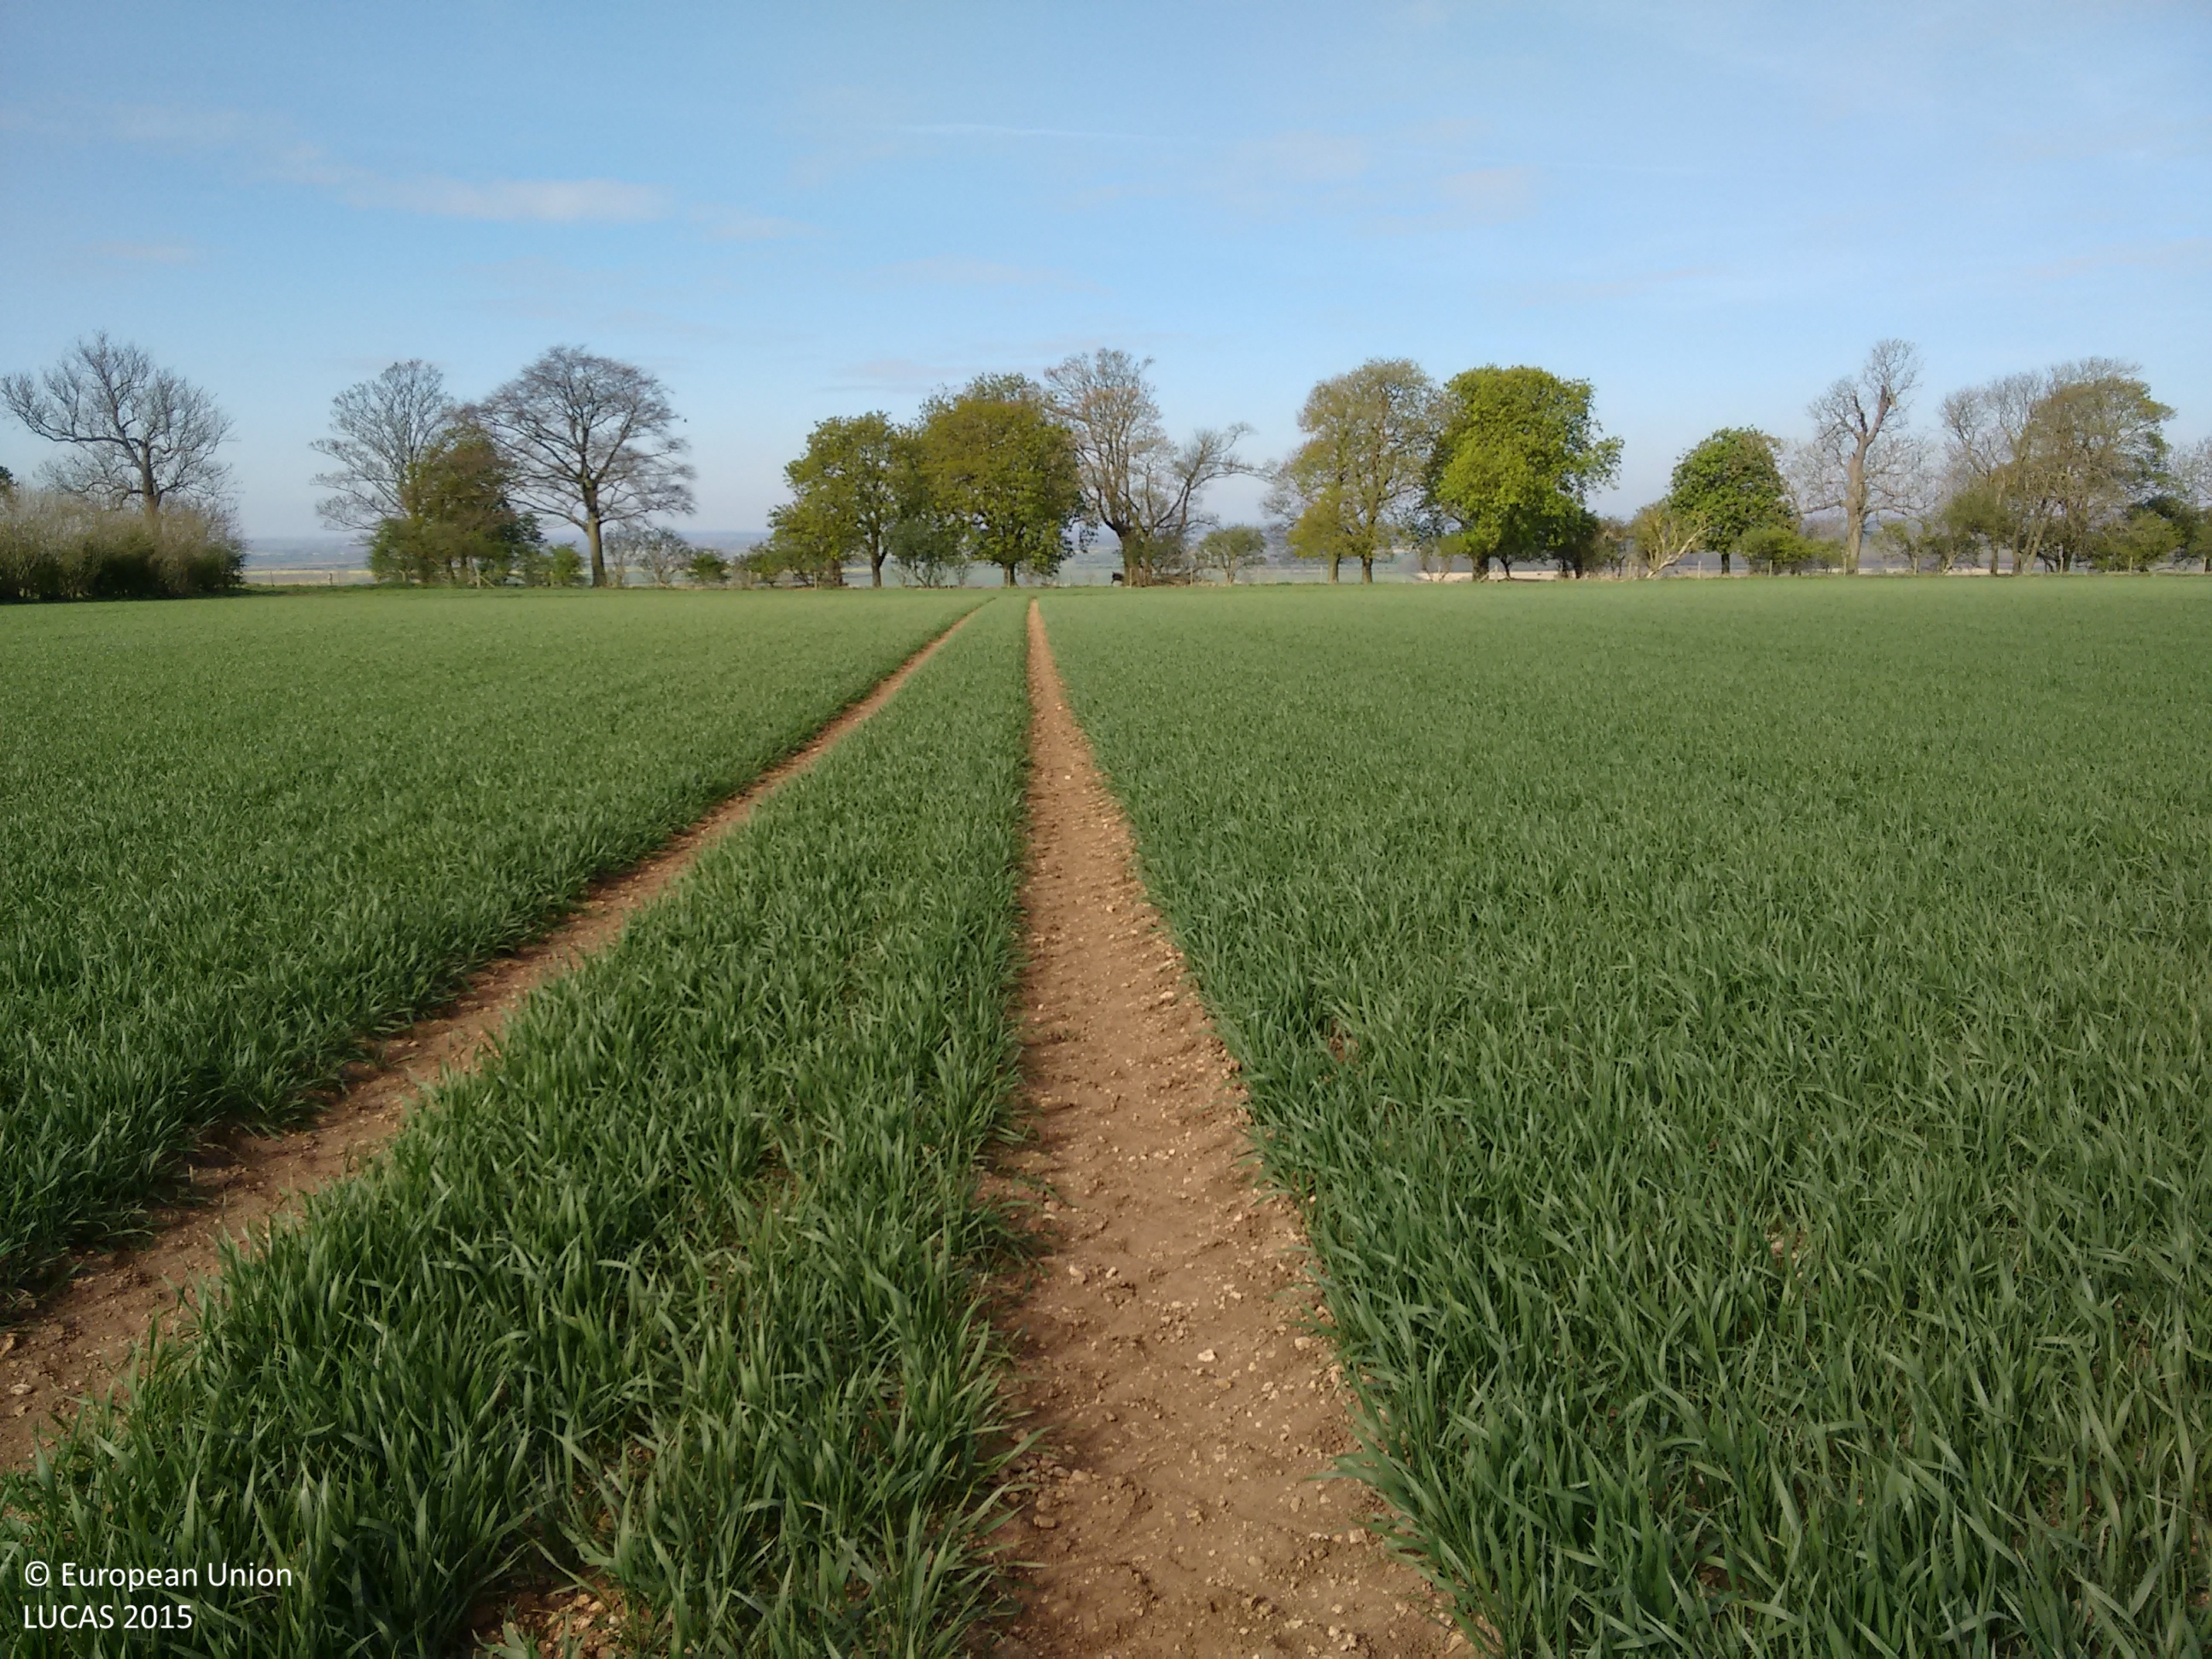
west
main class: Cropland
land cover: Common wheat
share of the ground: > 75 %
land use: Agriculture (excluding fallow land and kitchen gardens)
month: April
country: GB
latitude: 53.1395
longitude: -0.5472
